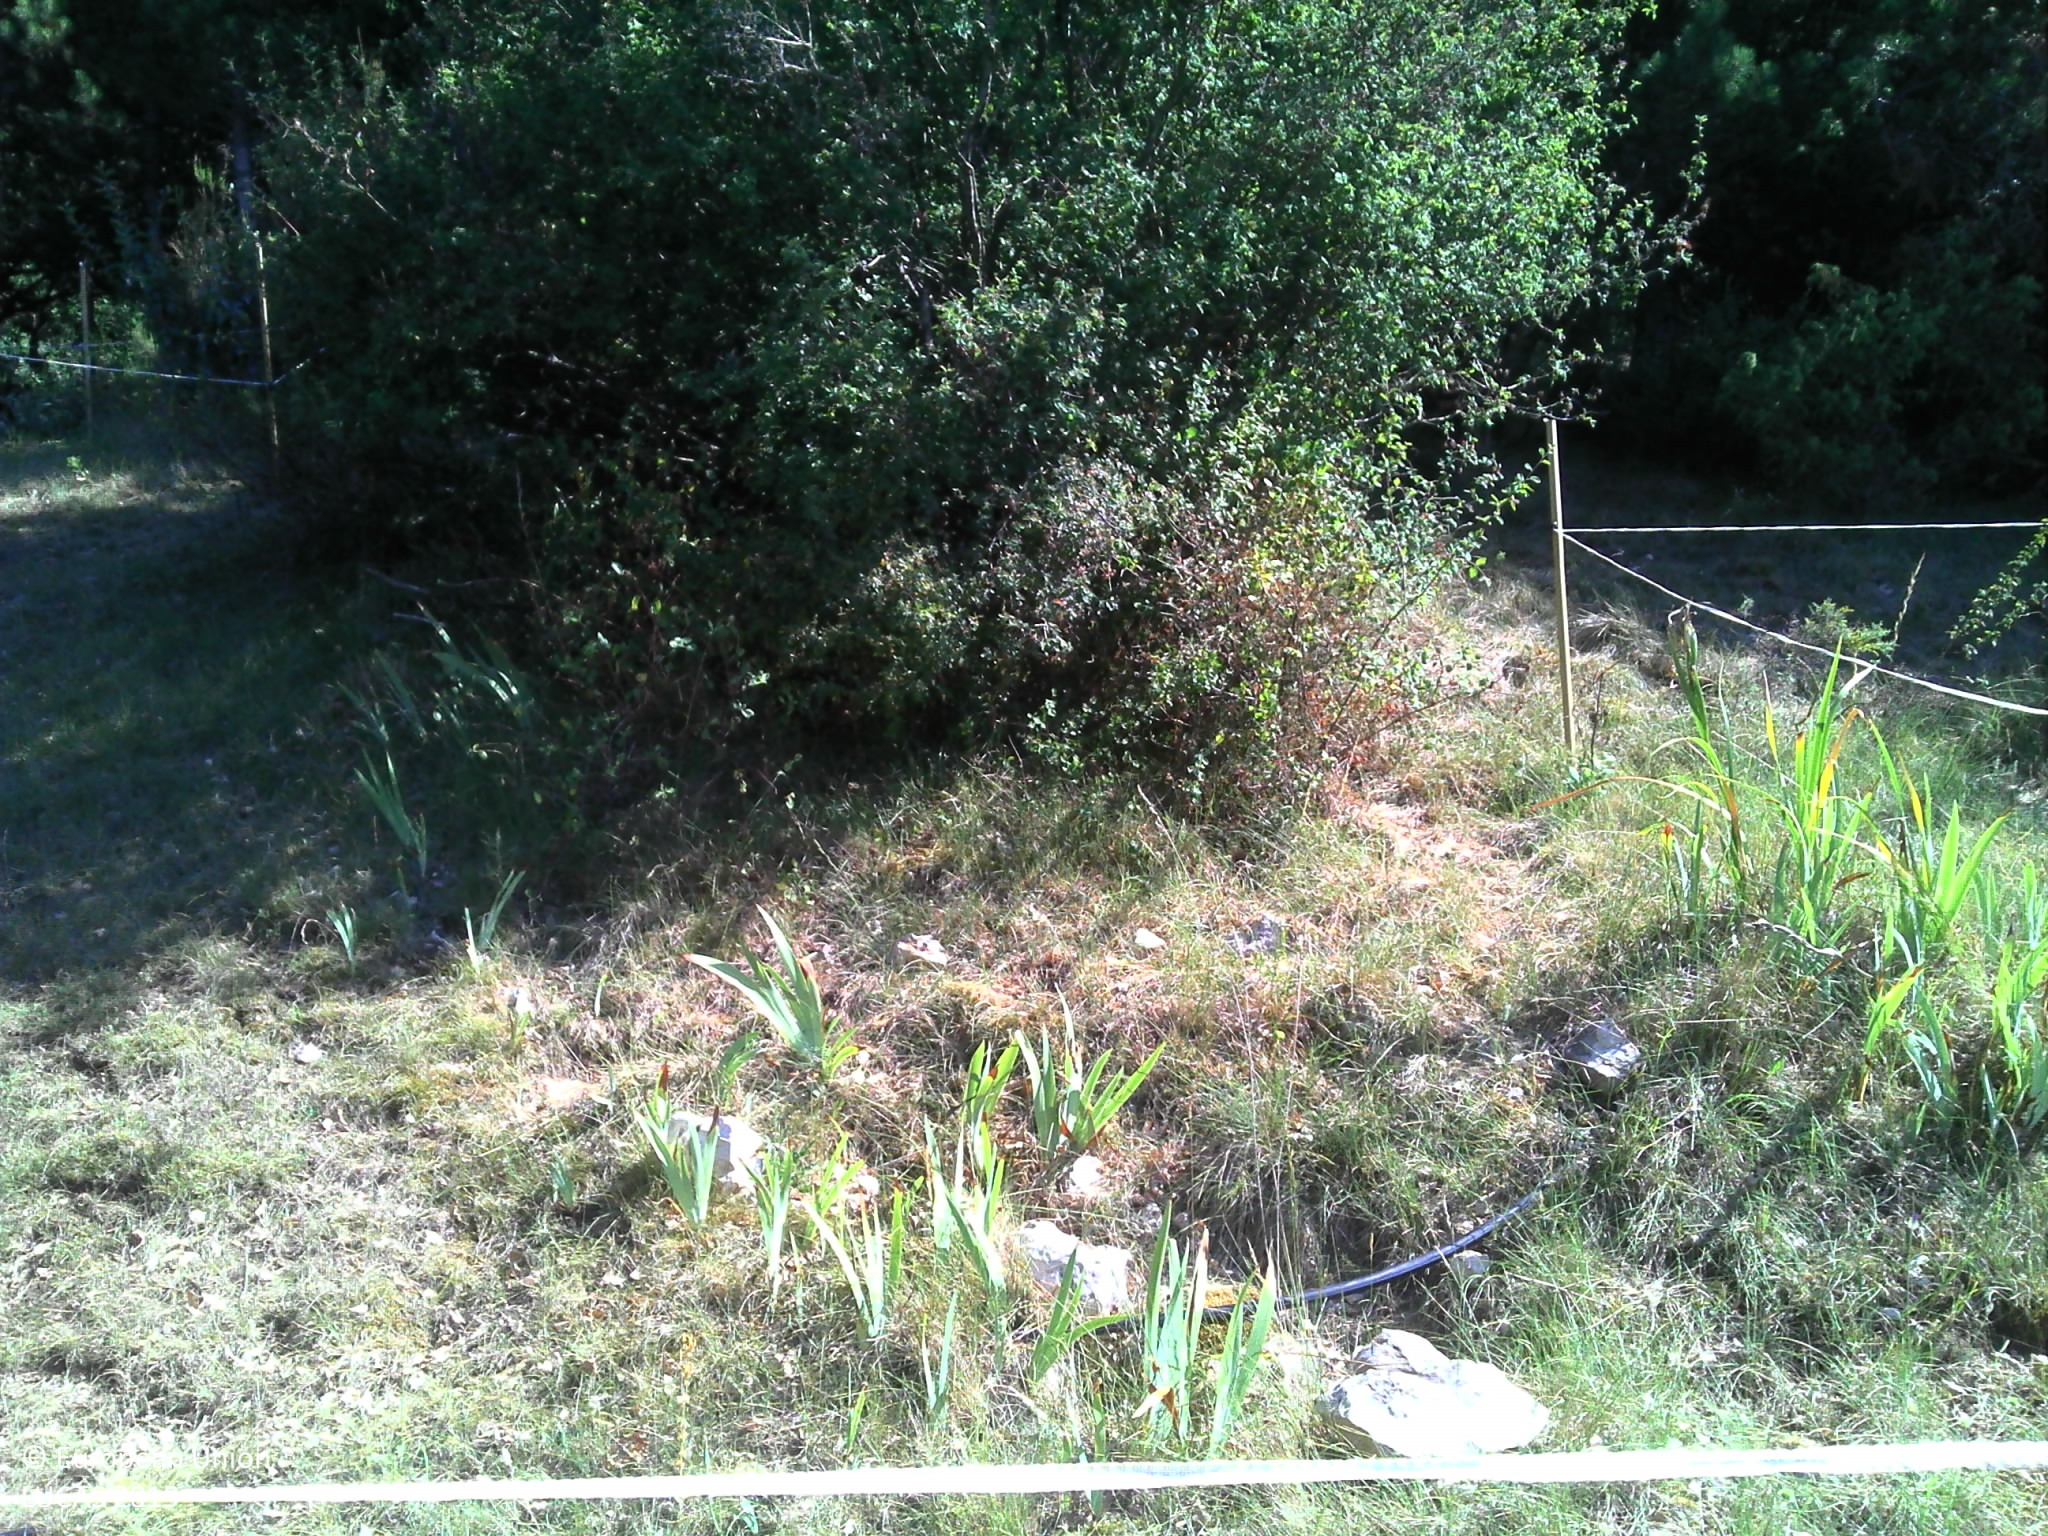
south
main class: Grassland
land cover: Grassland with sparse tree/shrub cover
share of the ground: > 75 %
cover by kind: herbaceous plants 95 %, coniferous forest trees 5 %
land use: Agriculture (excluding fallow land and kitchen gardens)
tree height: > 5 m
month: July
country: FR
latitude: 42.9297
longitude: 2.1550
